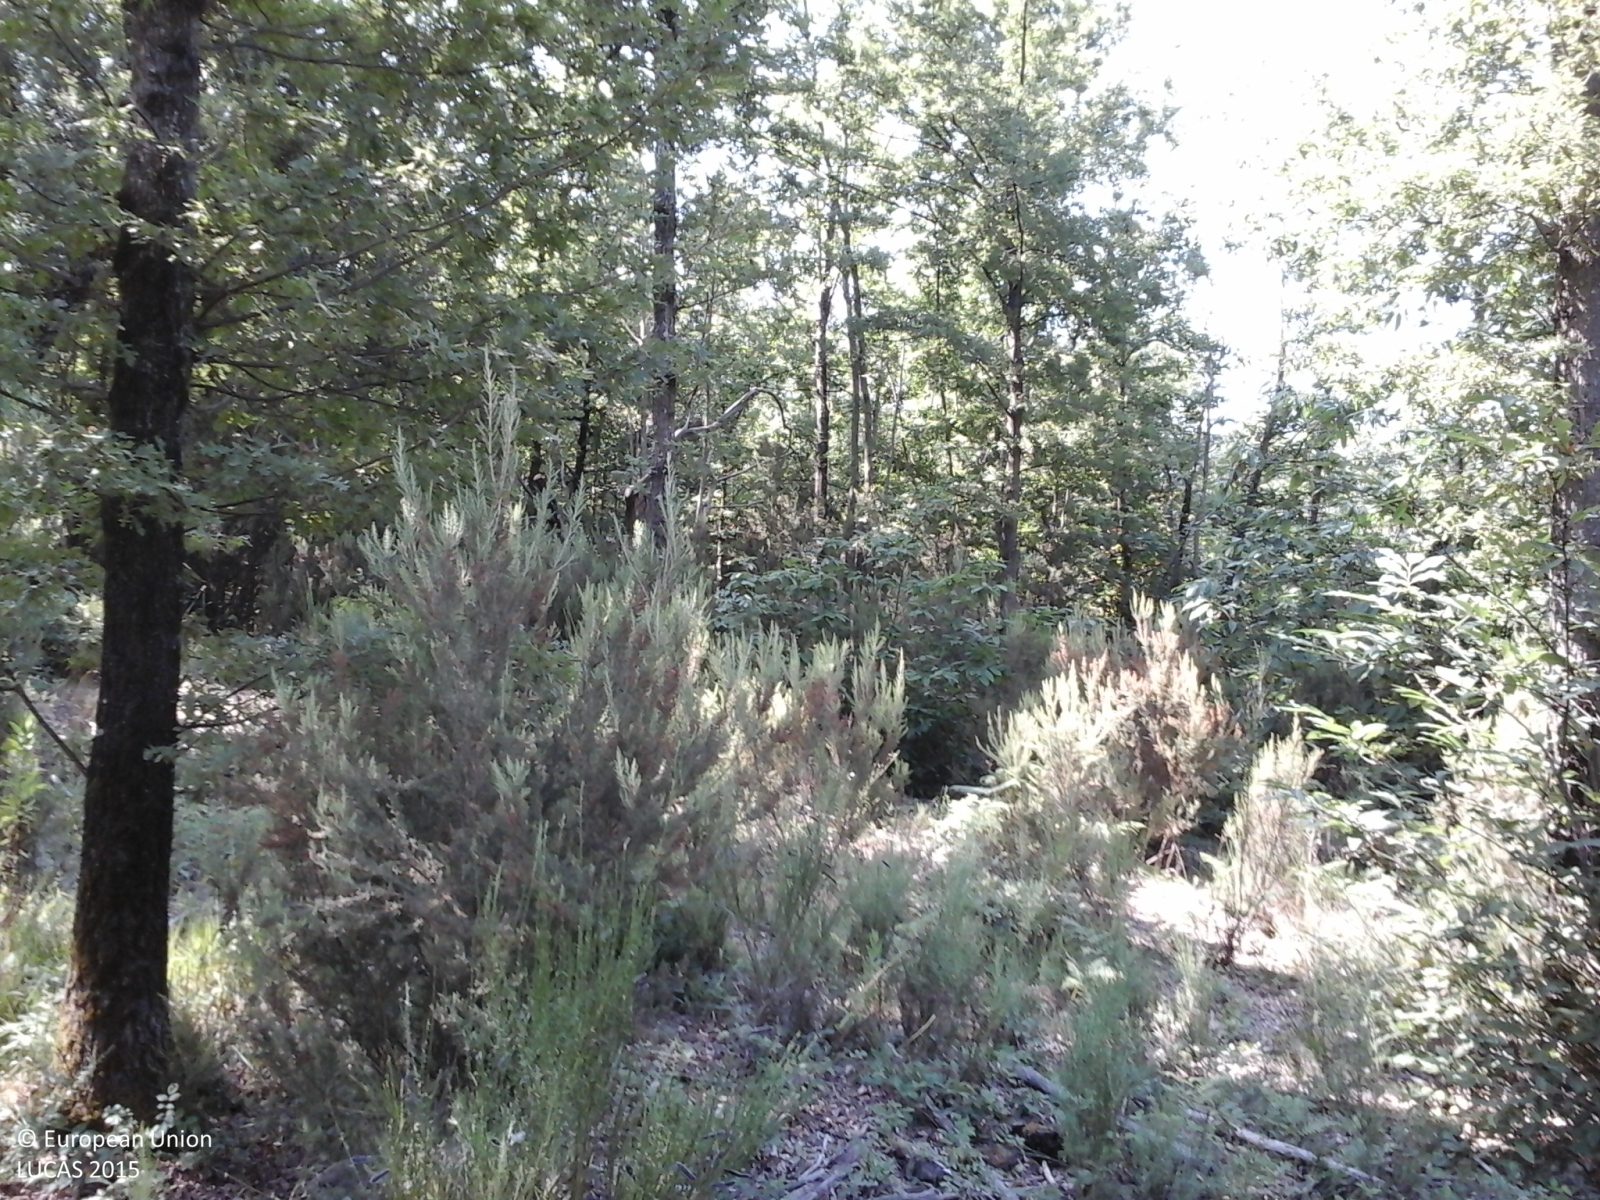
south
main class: Woodland
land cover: Broadleaved woodland
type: thermophilous deciduous forest
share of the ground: 50 - 75 %
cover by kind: shrubs 50 %, broadleaved forest trees 40 %, herbaceous plants 10 %
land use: Forestry
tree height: > 5 m
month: July
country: IT
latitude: 43.0630
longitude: 11.1385
